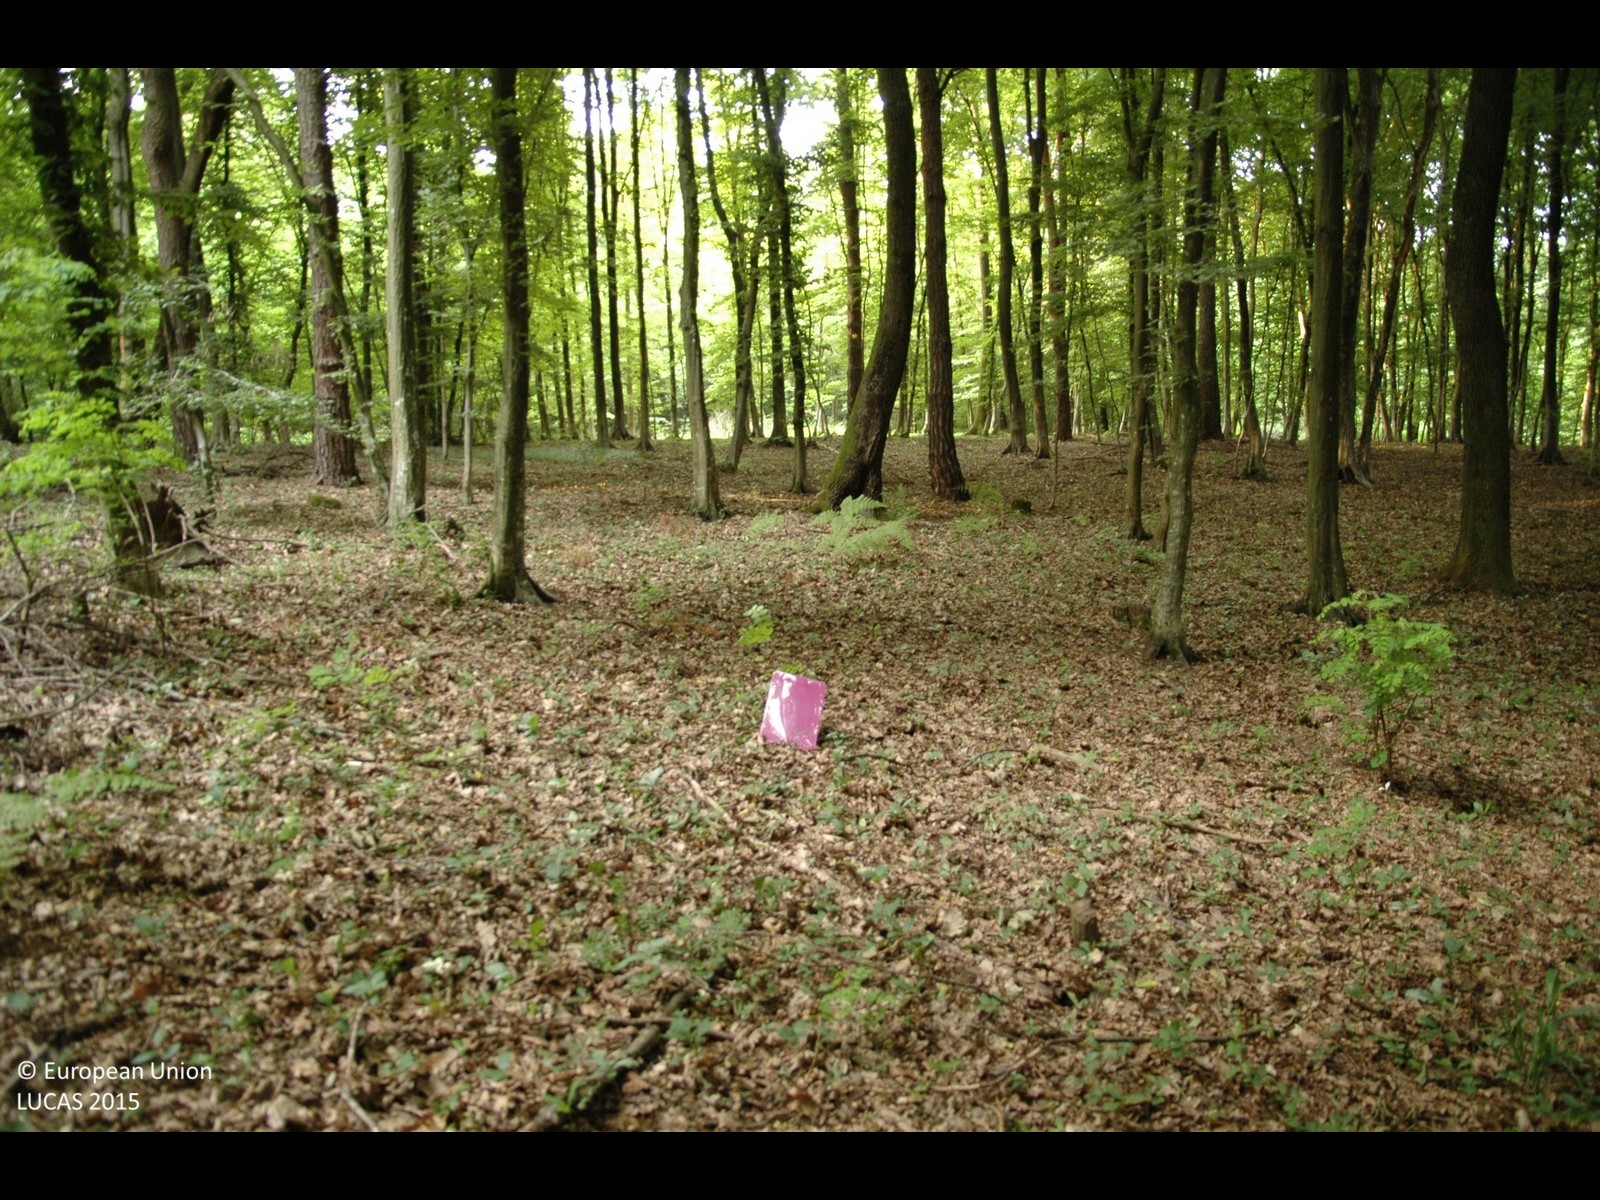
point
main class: Woodland
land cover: Broadleaved woodland
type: mesophytic deciduous forest
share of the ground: > 75 %
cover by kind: broadleaved forest trees 100 %
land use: Forestry
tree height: > 5 m
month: June
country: HR
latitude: 46.4357
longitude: 16.3127
